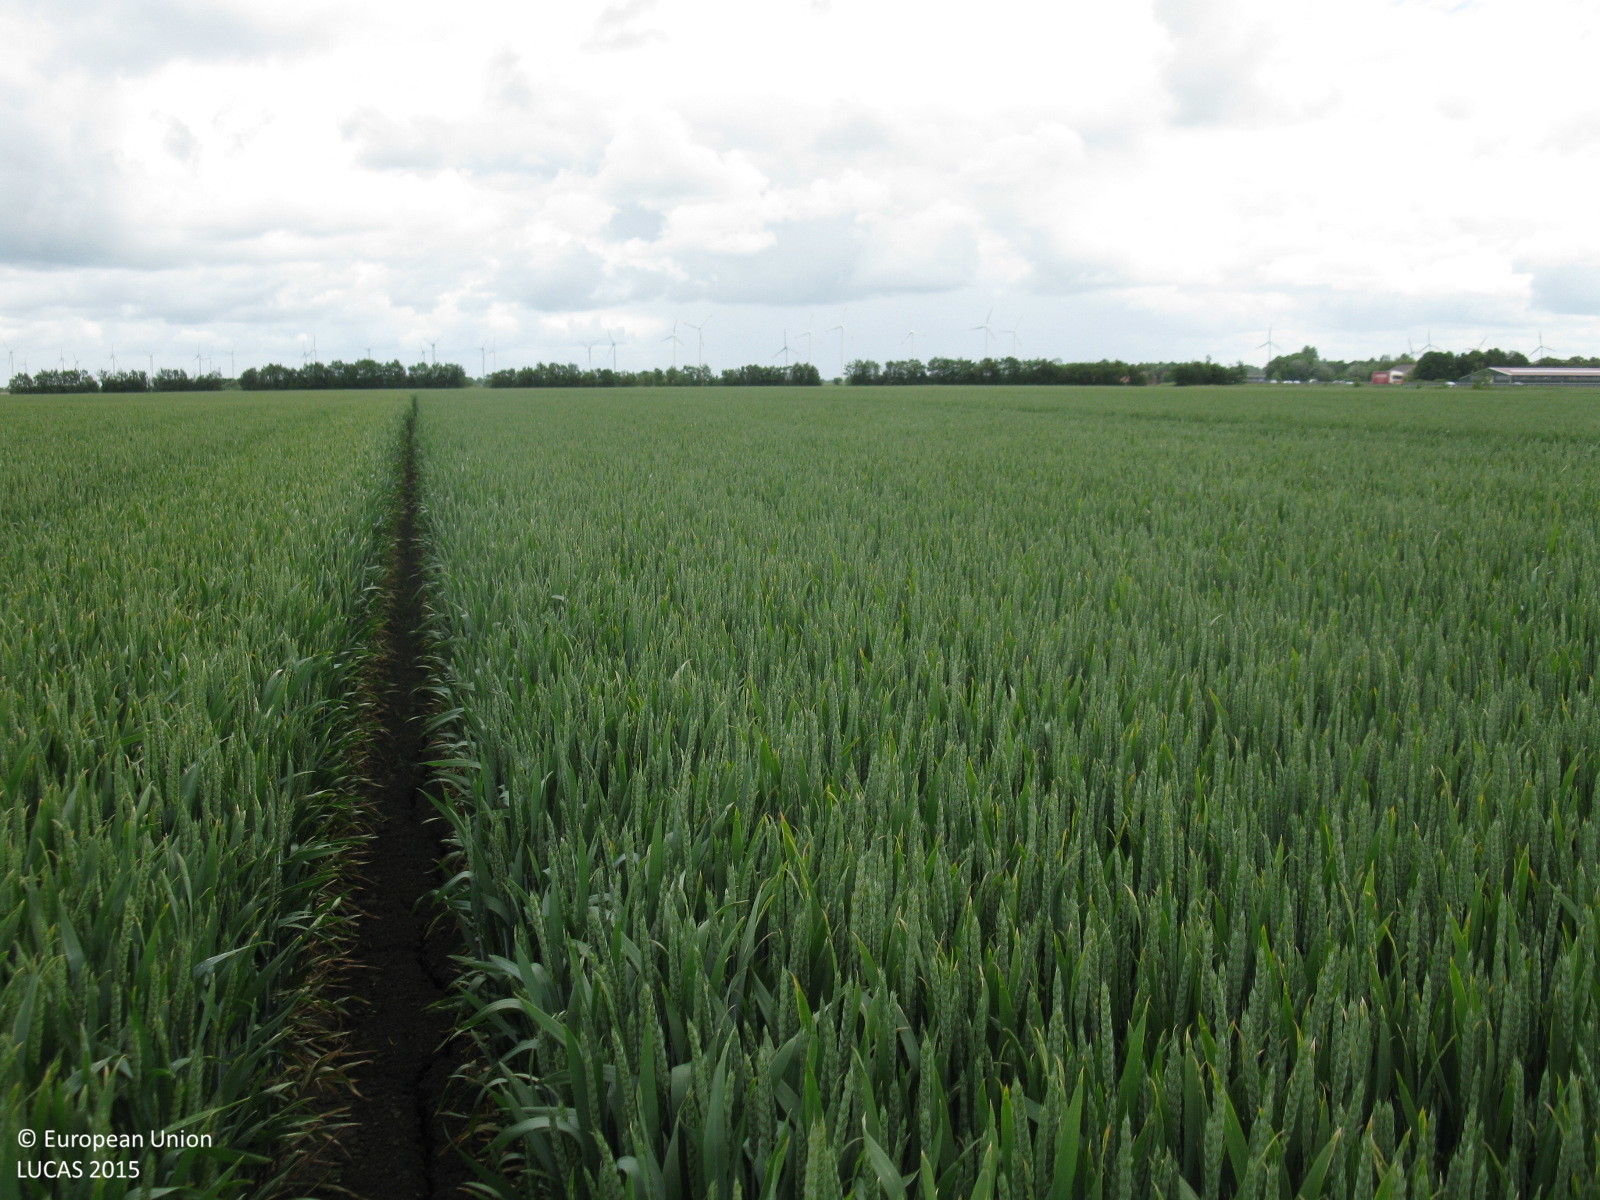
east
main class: Cropland
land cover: Common wheat
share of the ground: > 75 %
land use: Agriculture (excluding fallow land and kitchen gardens)
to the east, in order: Common wheat; Grassland without tree/shrub cover; Ditches and canals; Grassland without tree/shrub cover; Common wheat
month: June
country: DE
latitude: 53.3721
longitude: 7.3102
